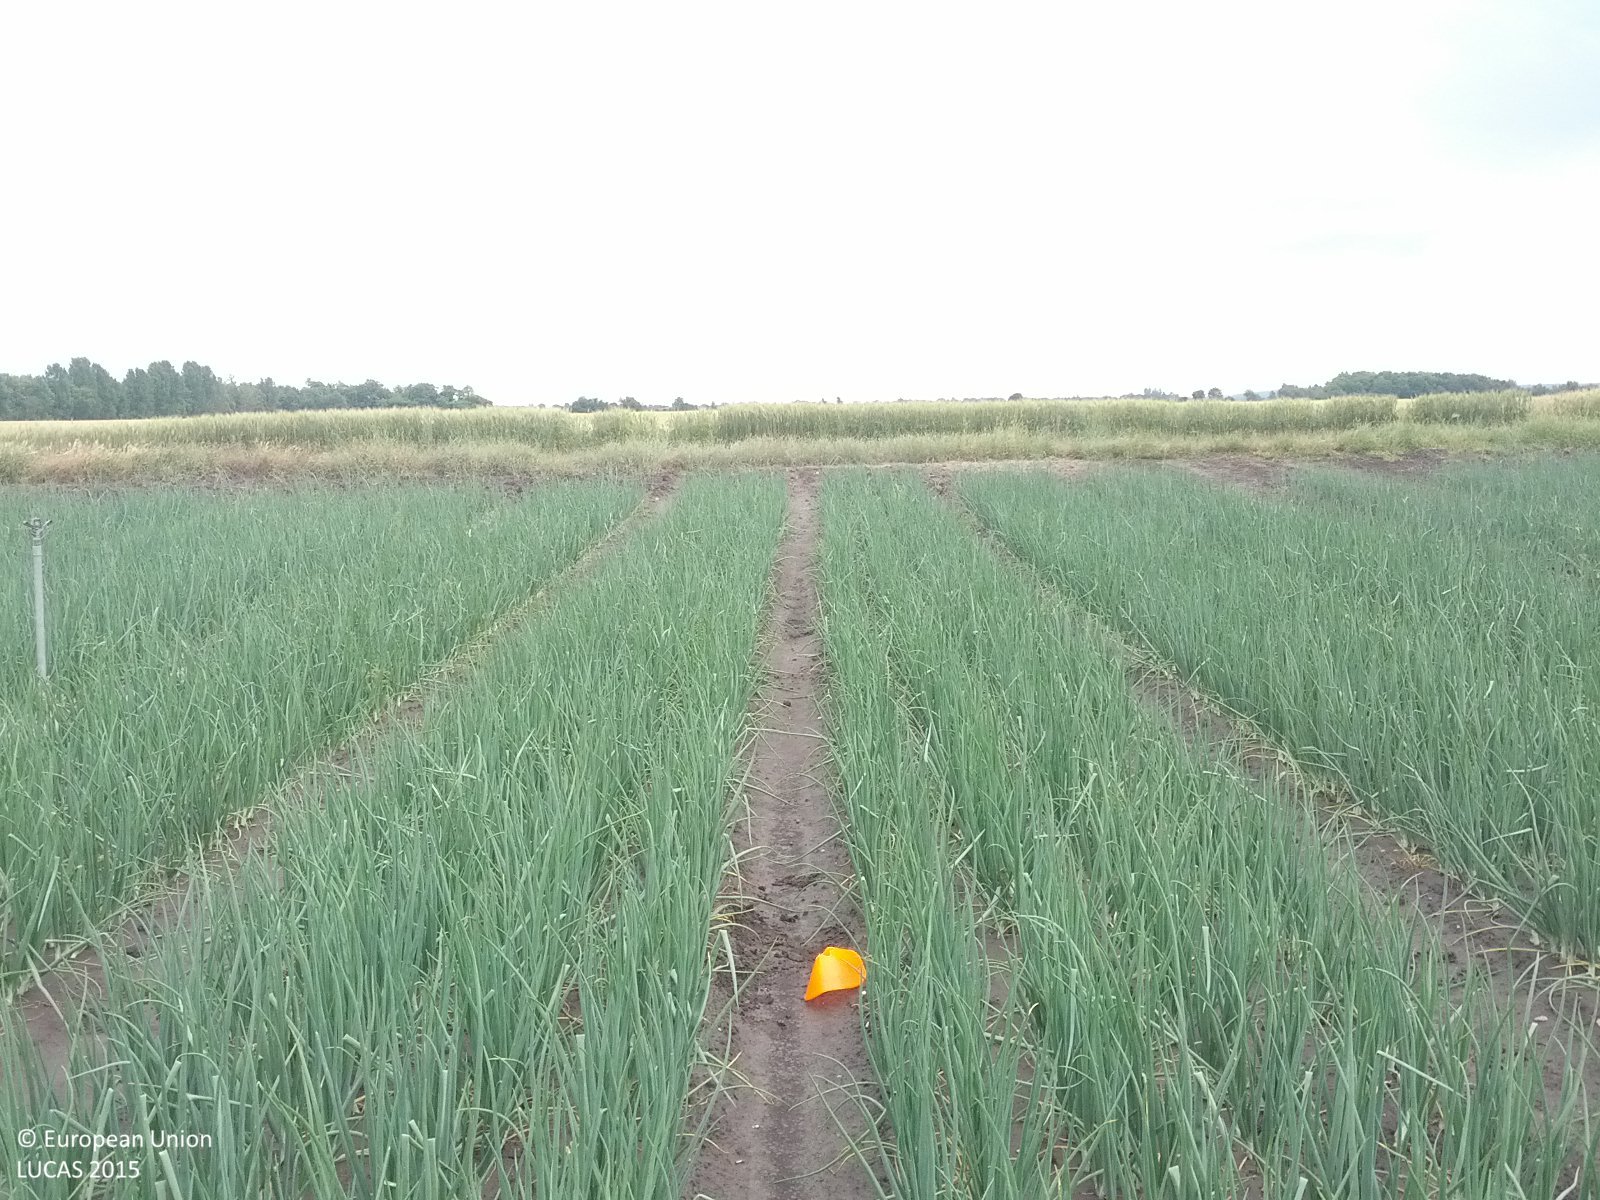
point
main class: Cropland
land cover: Other root crops
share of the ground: > 75 %
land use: Agriculture (excluding fallow land and kitchen gardens)
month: June
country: AT
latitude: 48.2136
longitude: 16.7760
